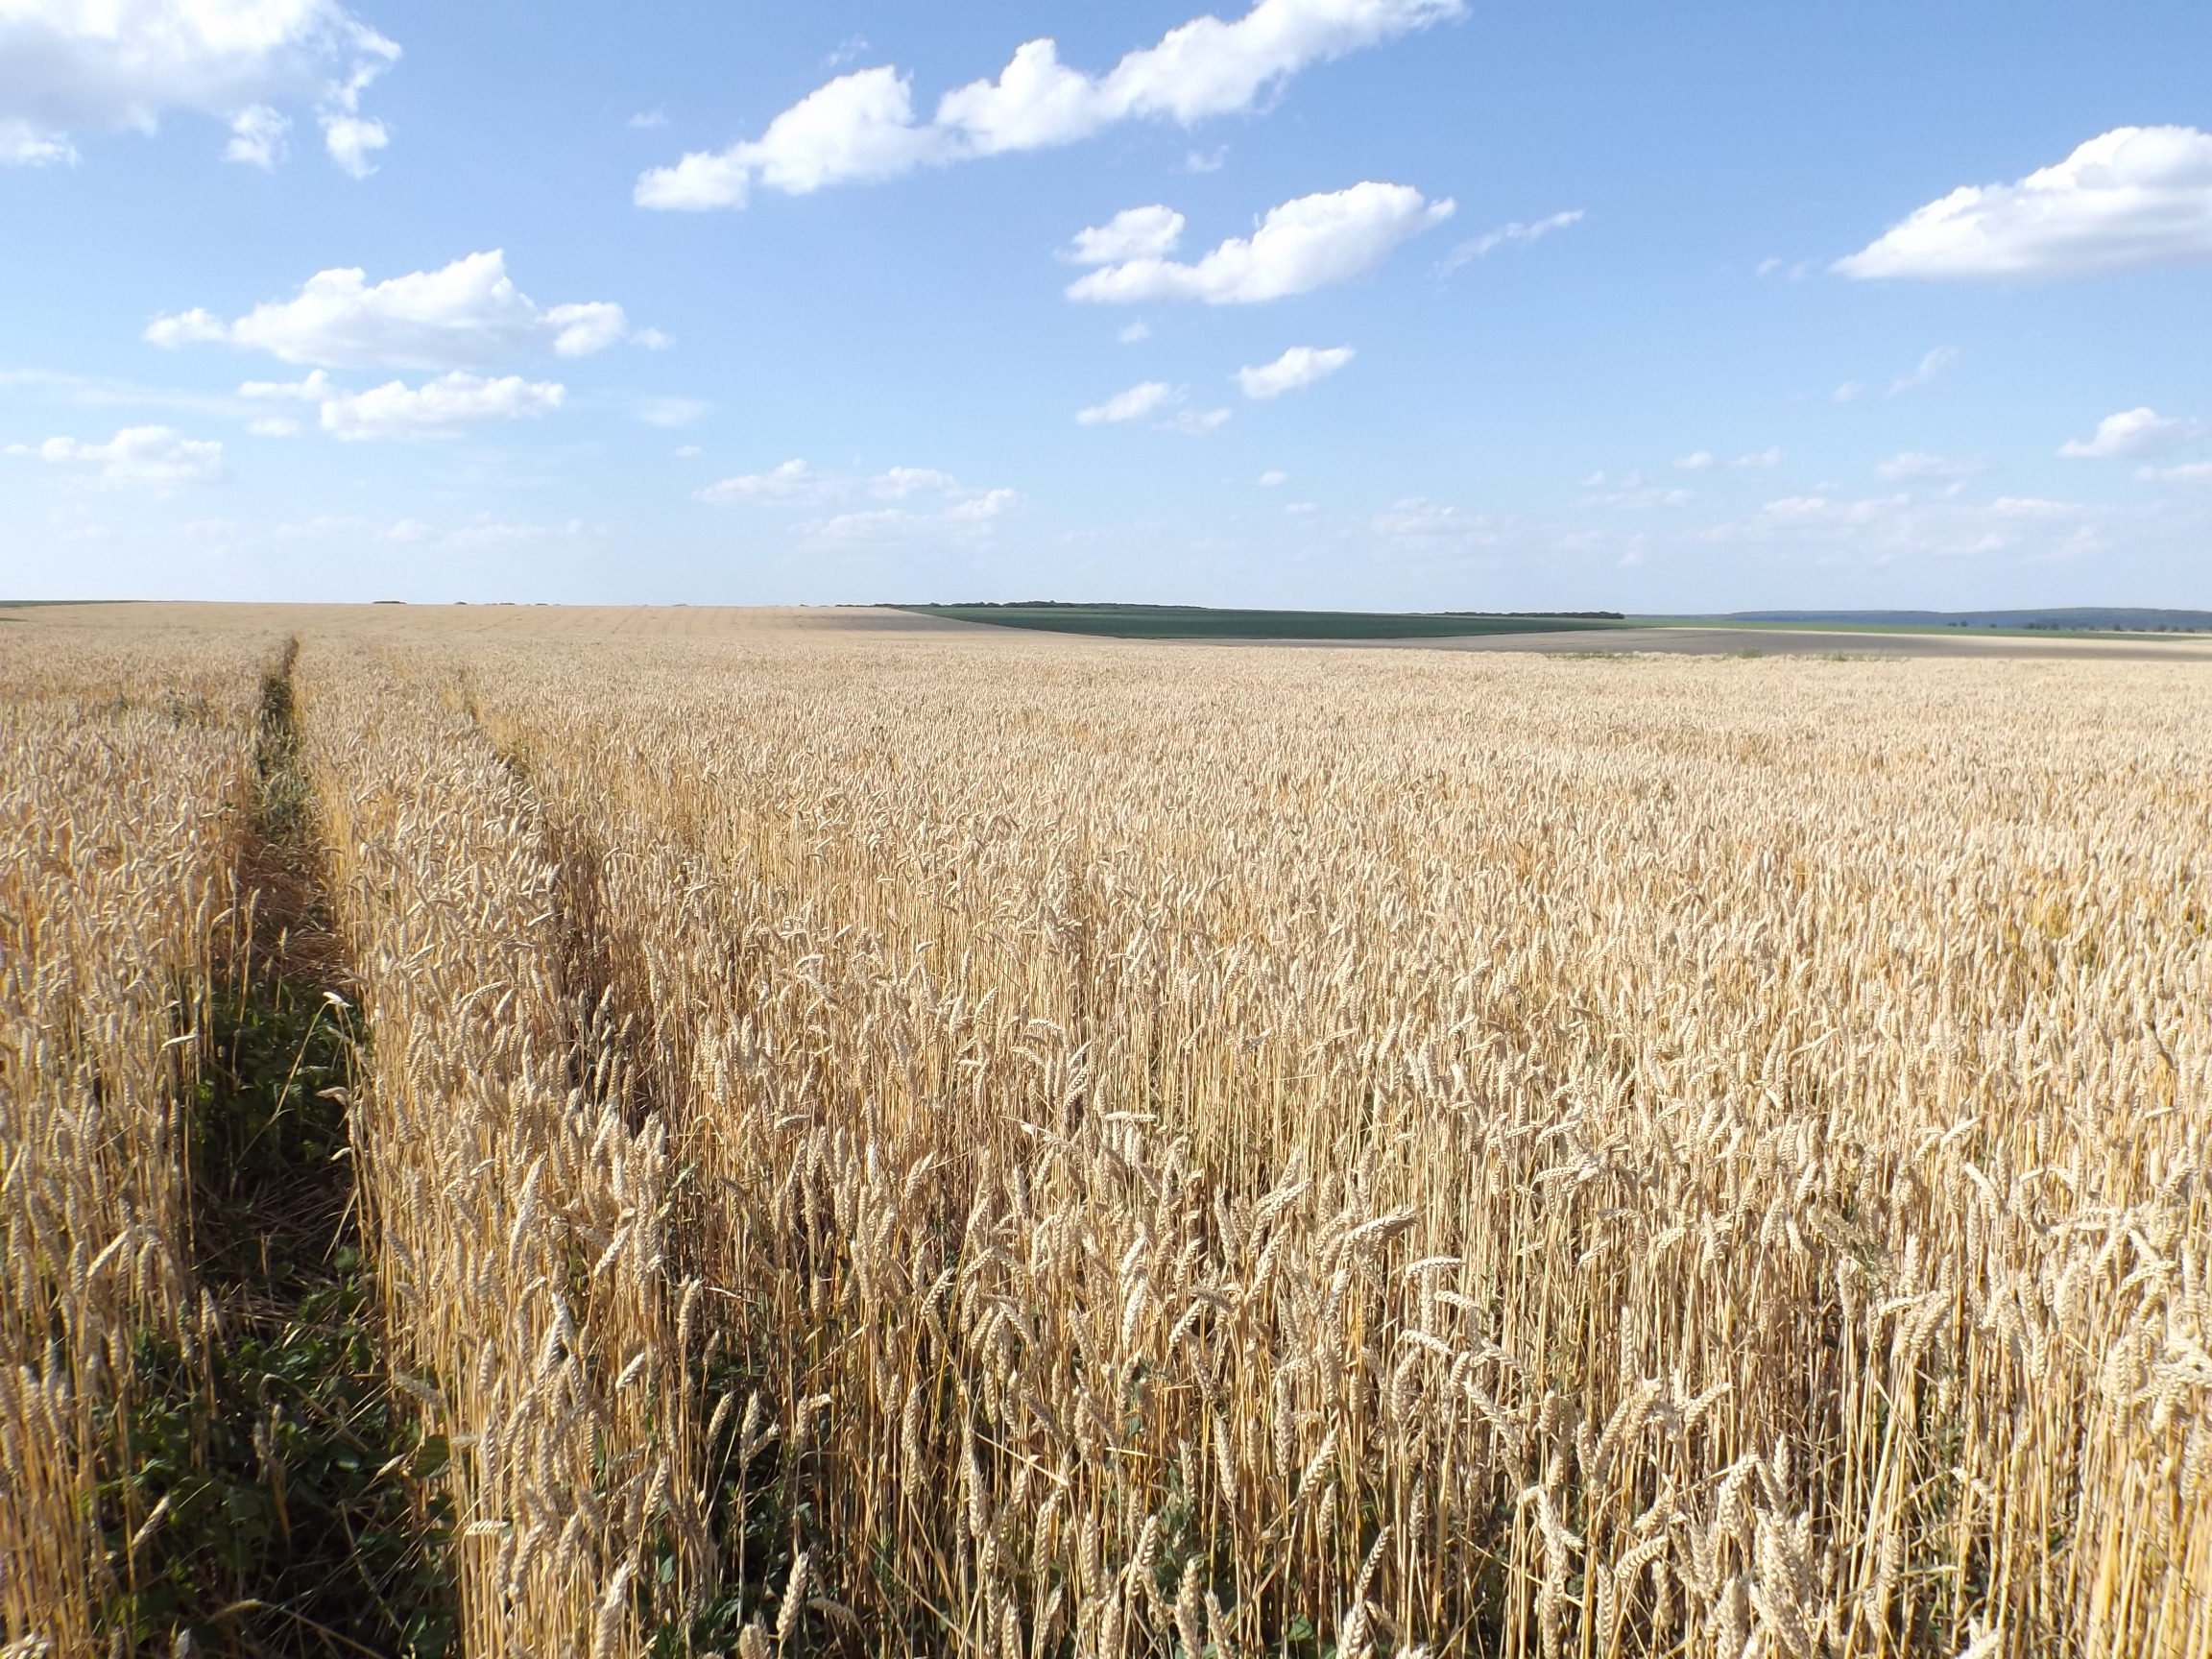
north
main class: Cropland
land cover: Common wheat
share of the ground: > 75 %
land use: Agriculture (excluding fallow land and kitchen gardens)
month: June
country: BG
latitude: 43.4637
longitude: 27.6745
